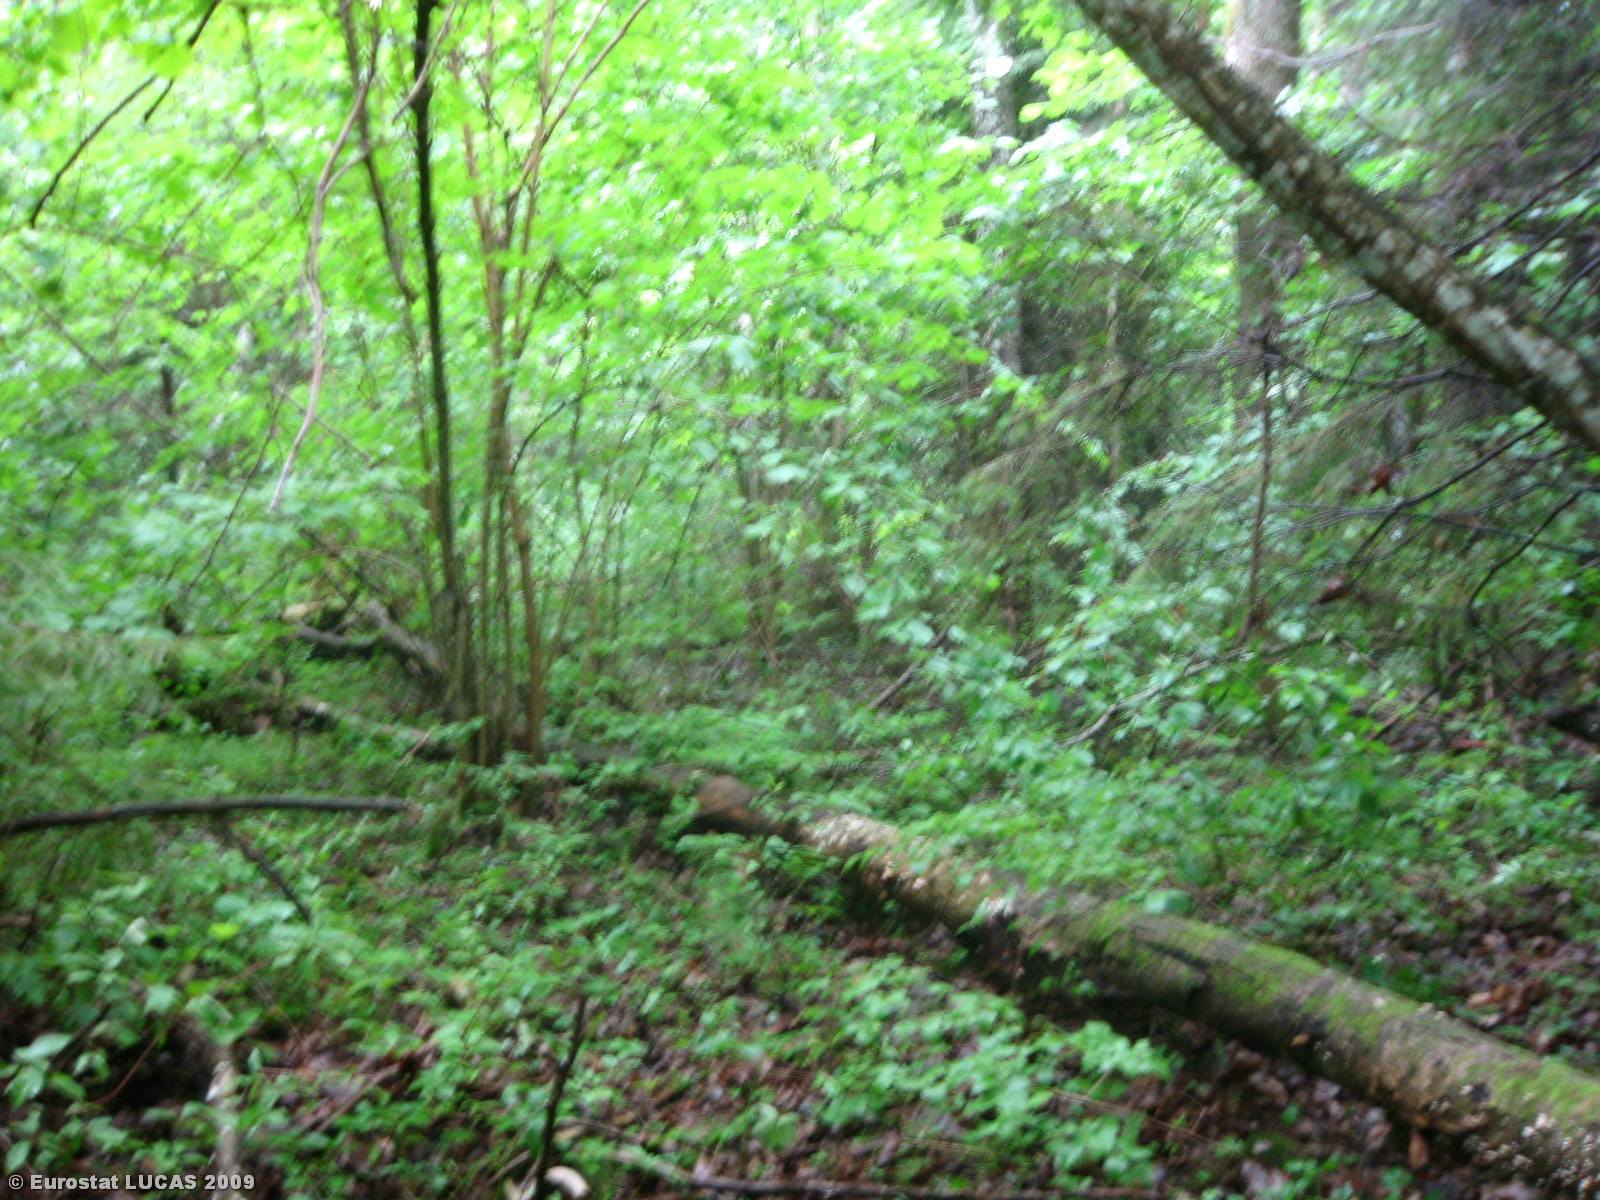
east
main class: Woodland
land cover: Mixed woodland
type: hemiboreal forest and nemoral coniferous forest and mixed broadleaved-coniferous forest
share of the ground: > 75 %
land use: Forestry
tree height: > 5 m
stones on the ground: < 10 %
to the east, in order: Mixed woodland
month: July
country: LT
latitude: 55.1525
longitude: 24.8446
